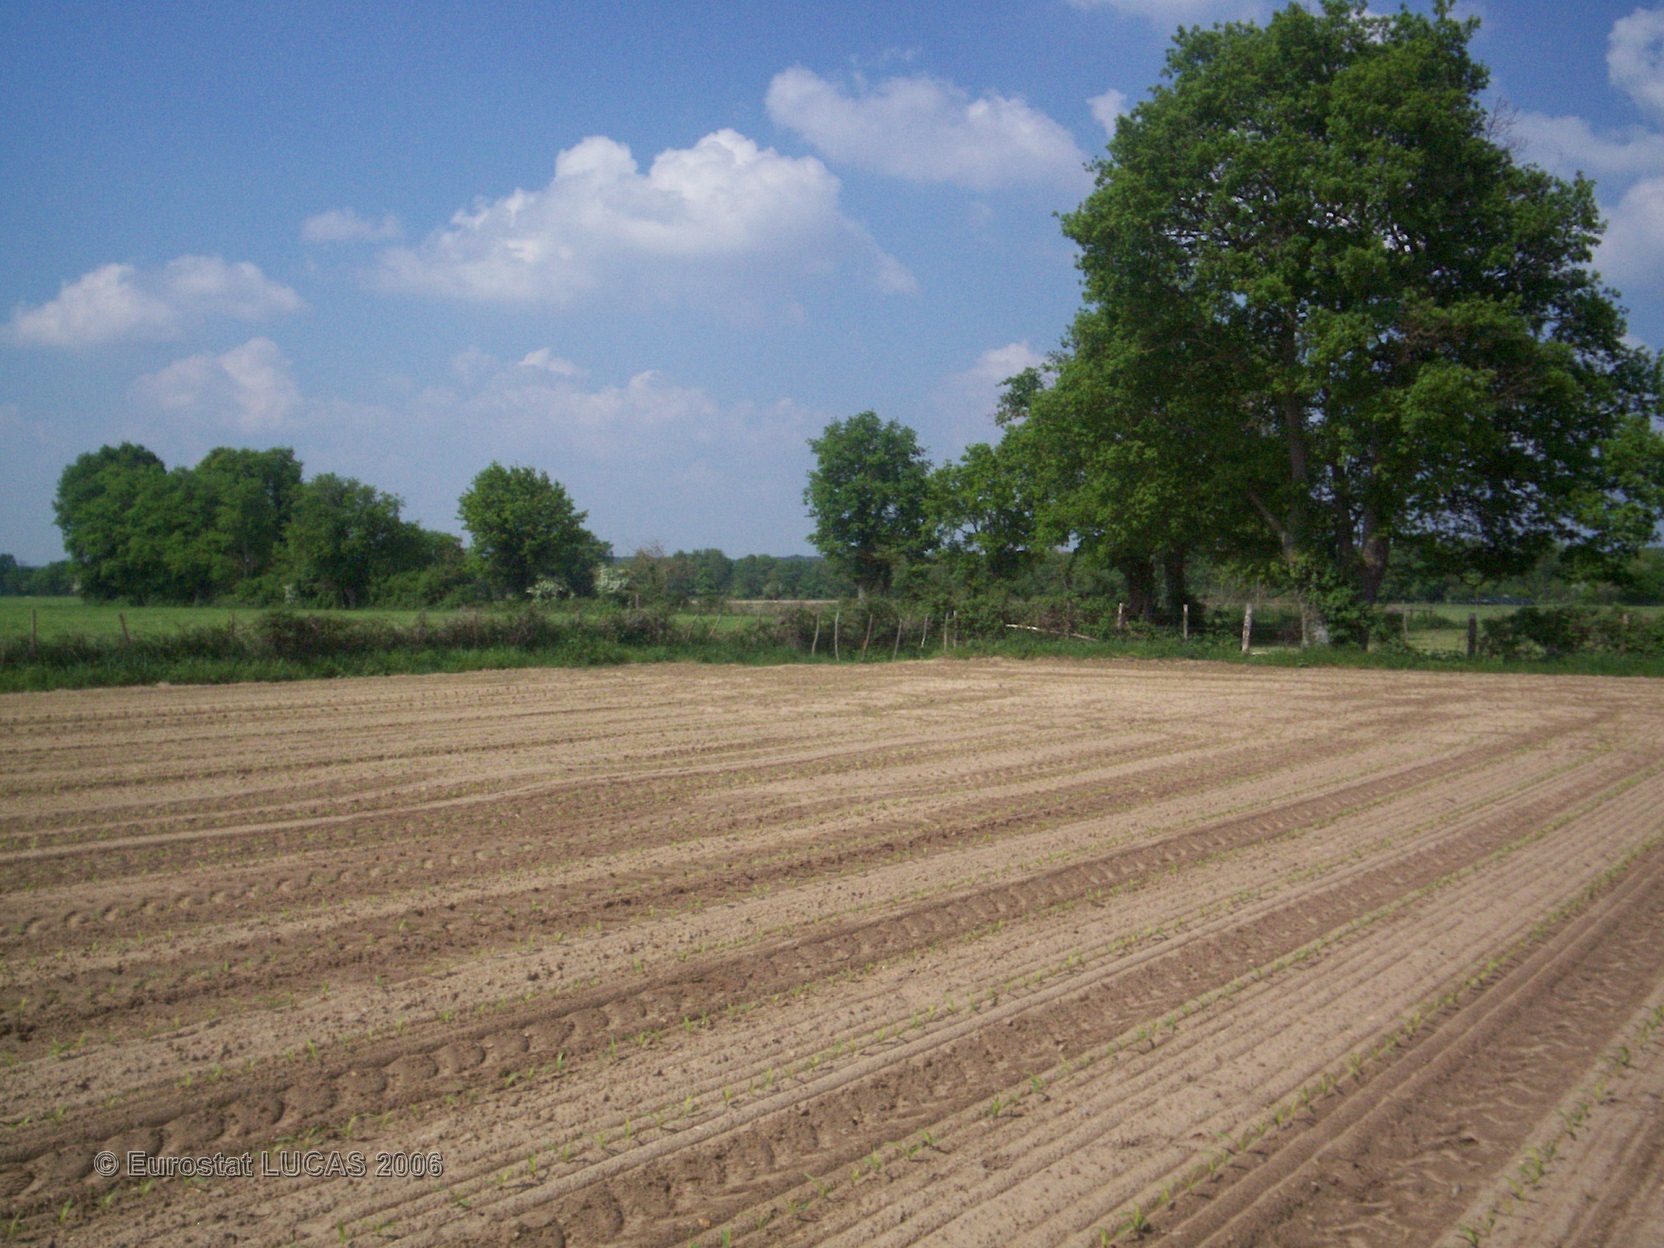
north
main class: Cropland
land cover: Maize
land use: Agriculture (excluding fallow land and kitchen gardens)
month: May
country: FR
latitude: 47.6402
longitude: 0.1920
